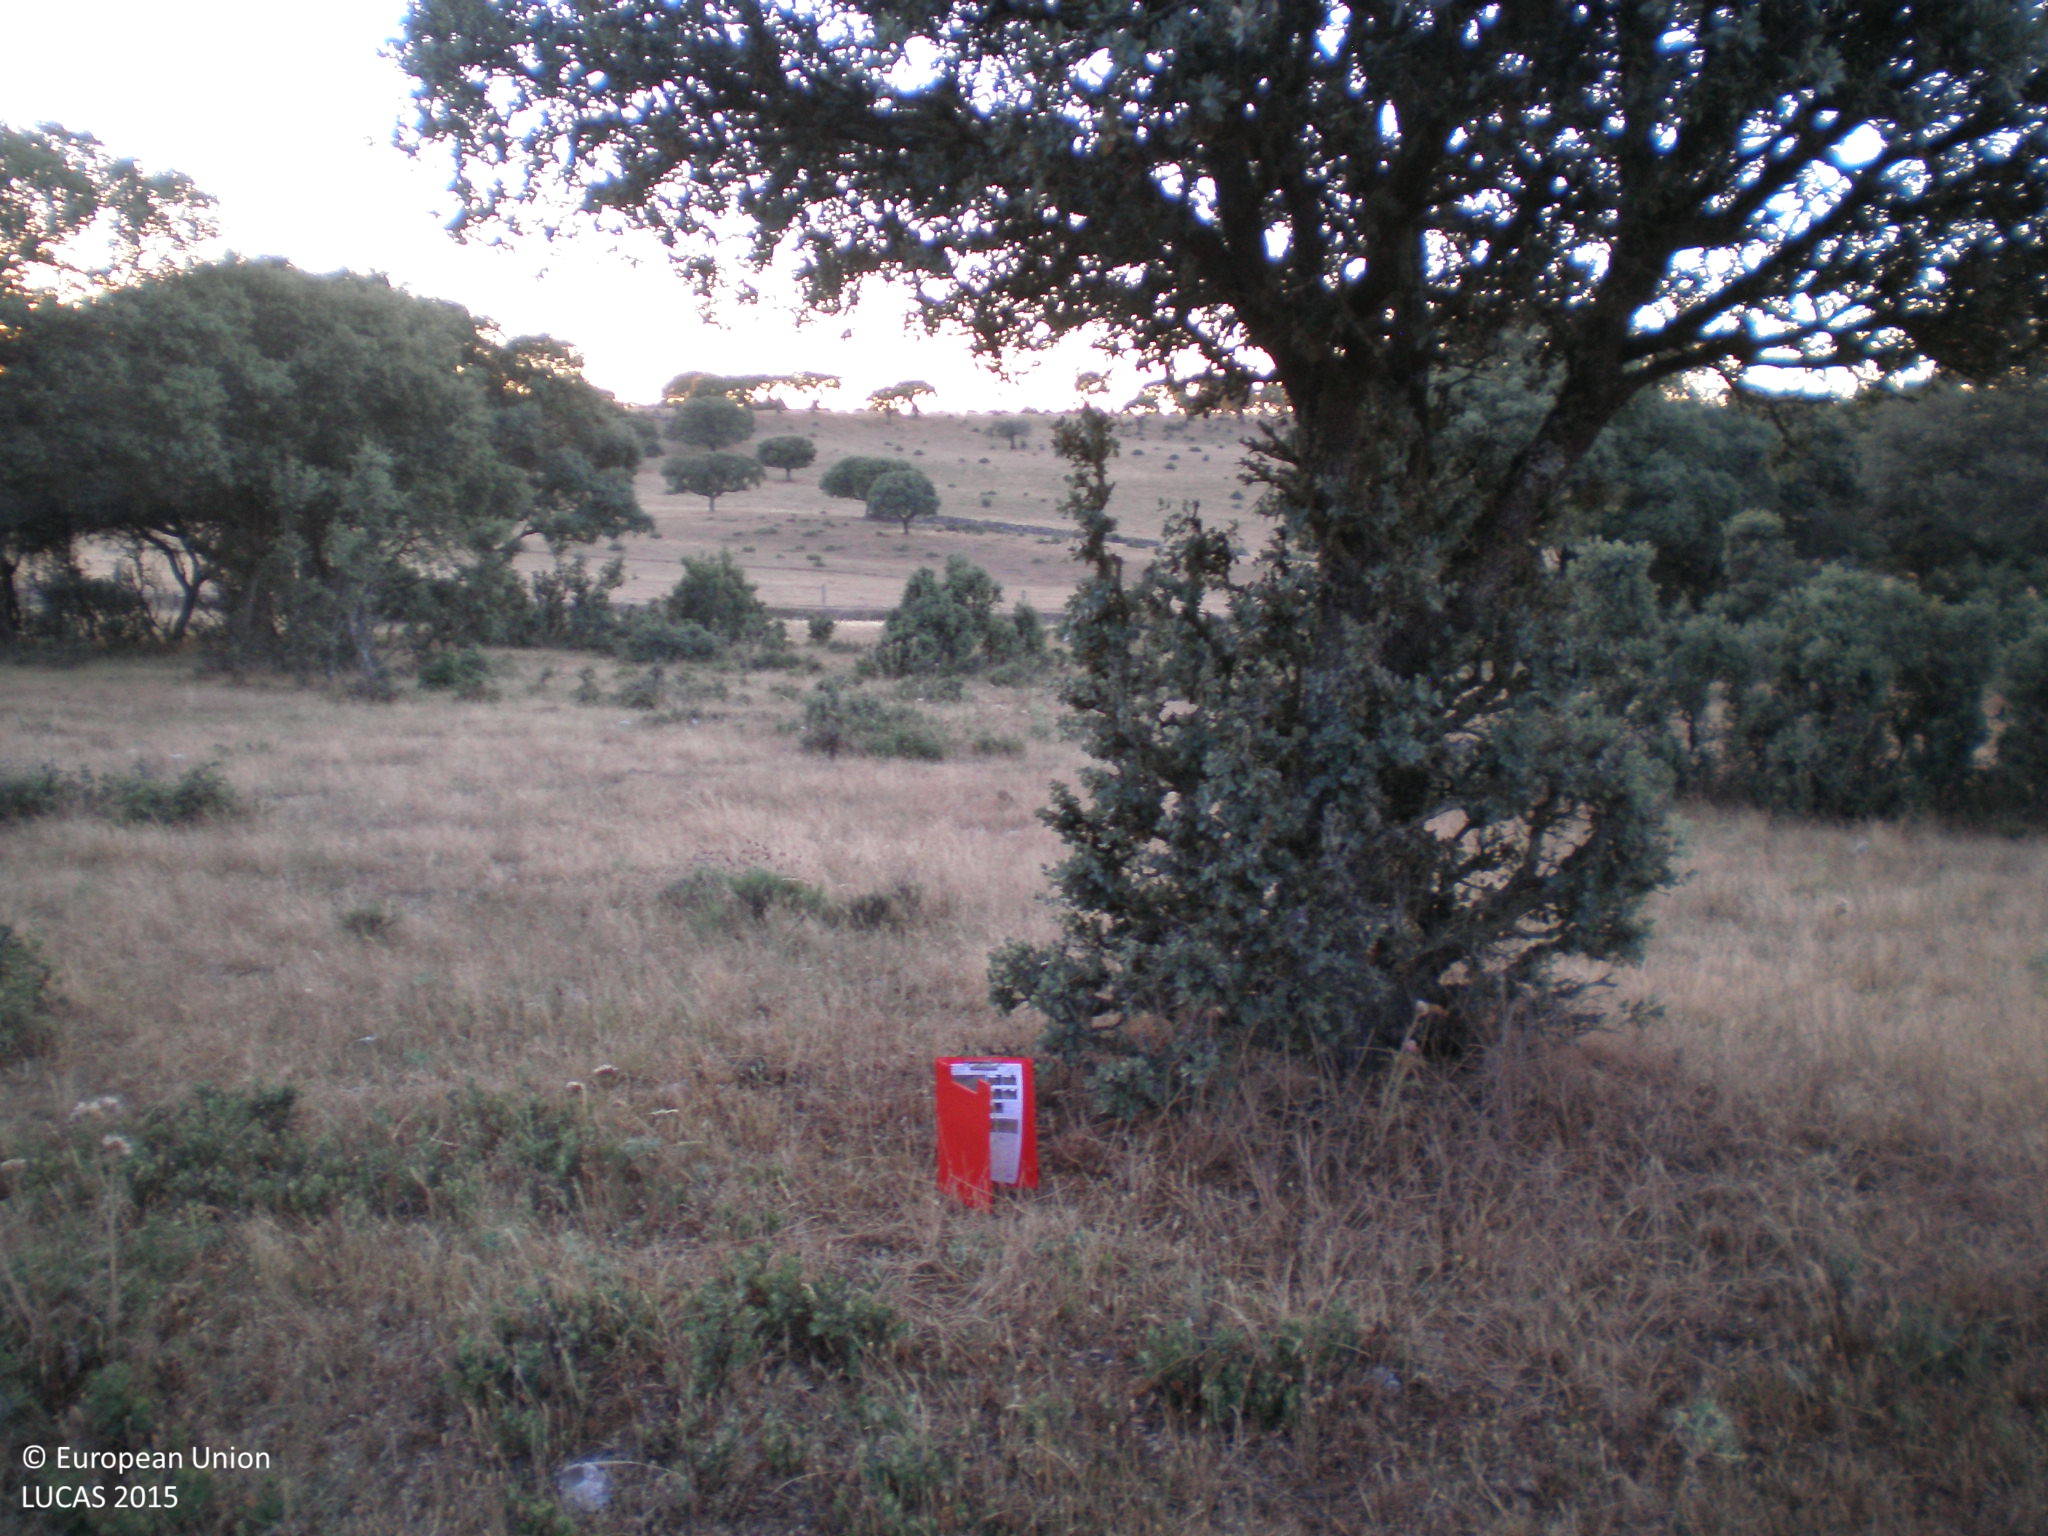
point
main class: Woodland
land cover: Broadleaved woodland
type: broadleaved evergreen forest
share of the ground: 25 - 50 %
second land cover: Grassland without tree/shrub cover
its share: 50 - 75 %
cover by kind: herbaceous plants 70 %, broadleaved forest trees 30 %
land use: Forestry
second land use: Agriculture (excluding fallow land and kitchen gardens)
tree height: < 5 m
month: June
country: ES
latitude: 40.6536
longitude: -5.6724
